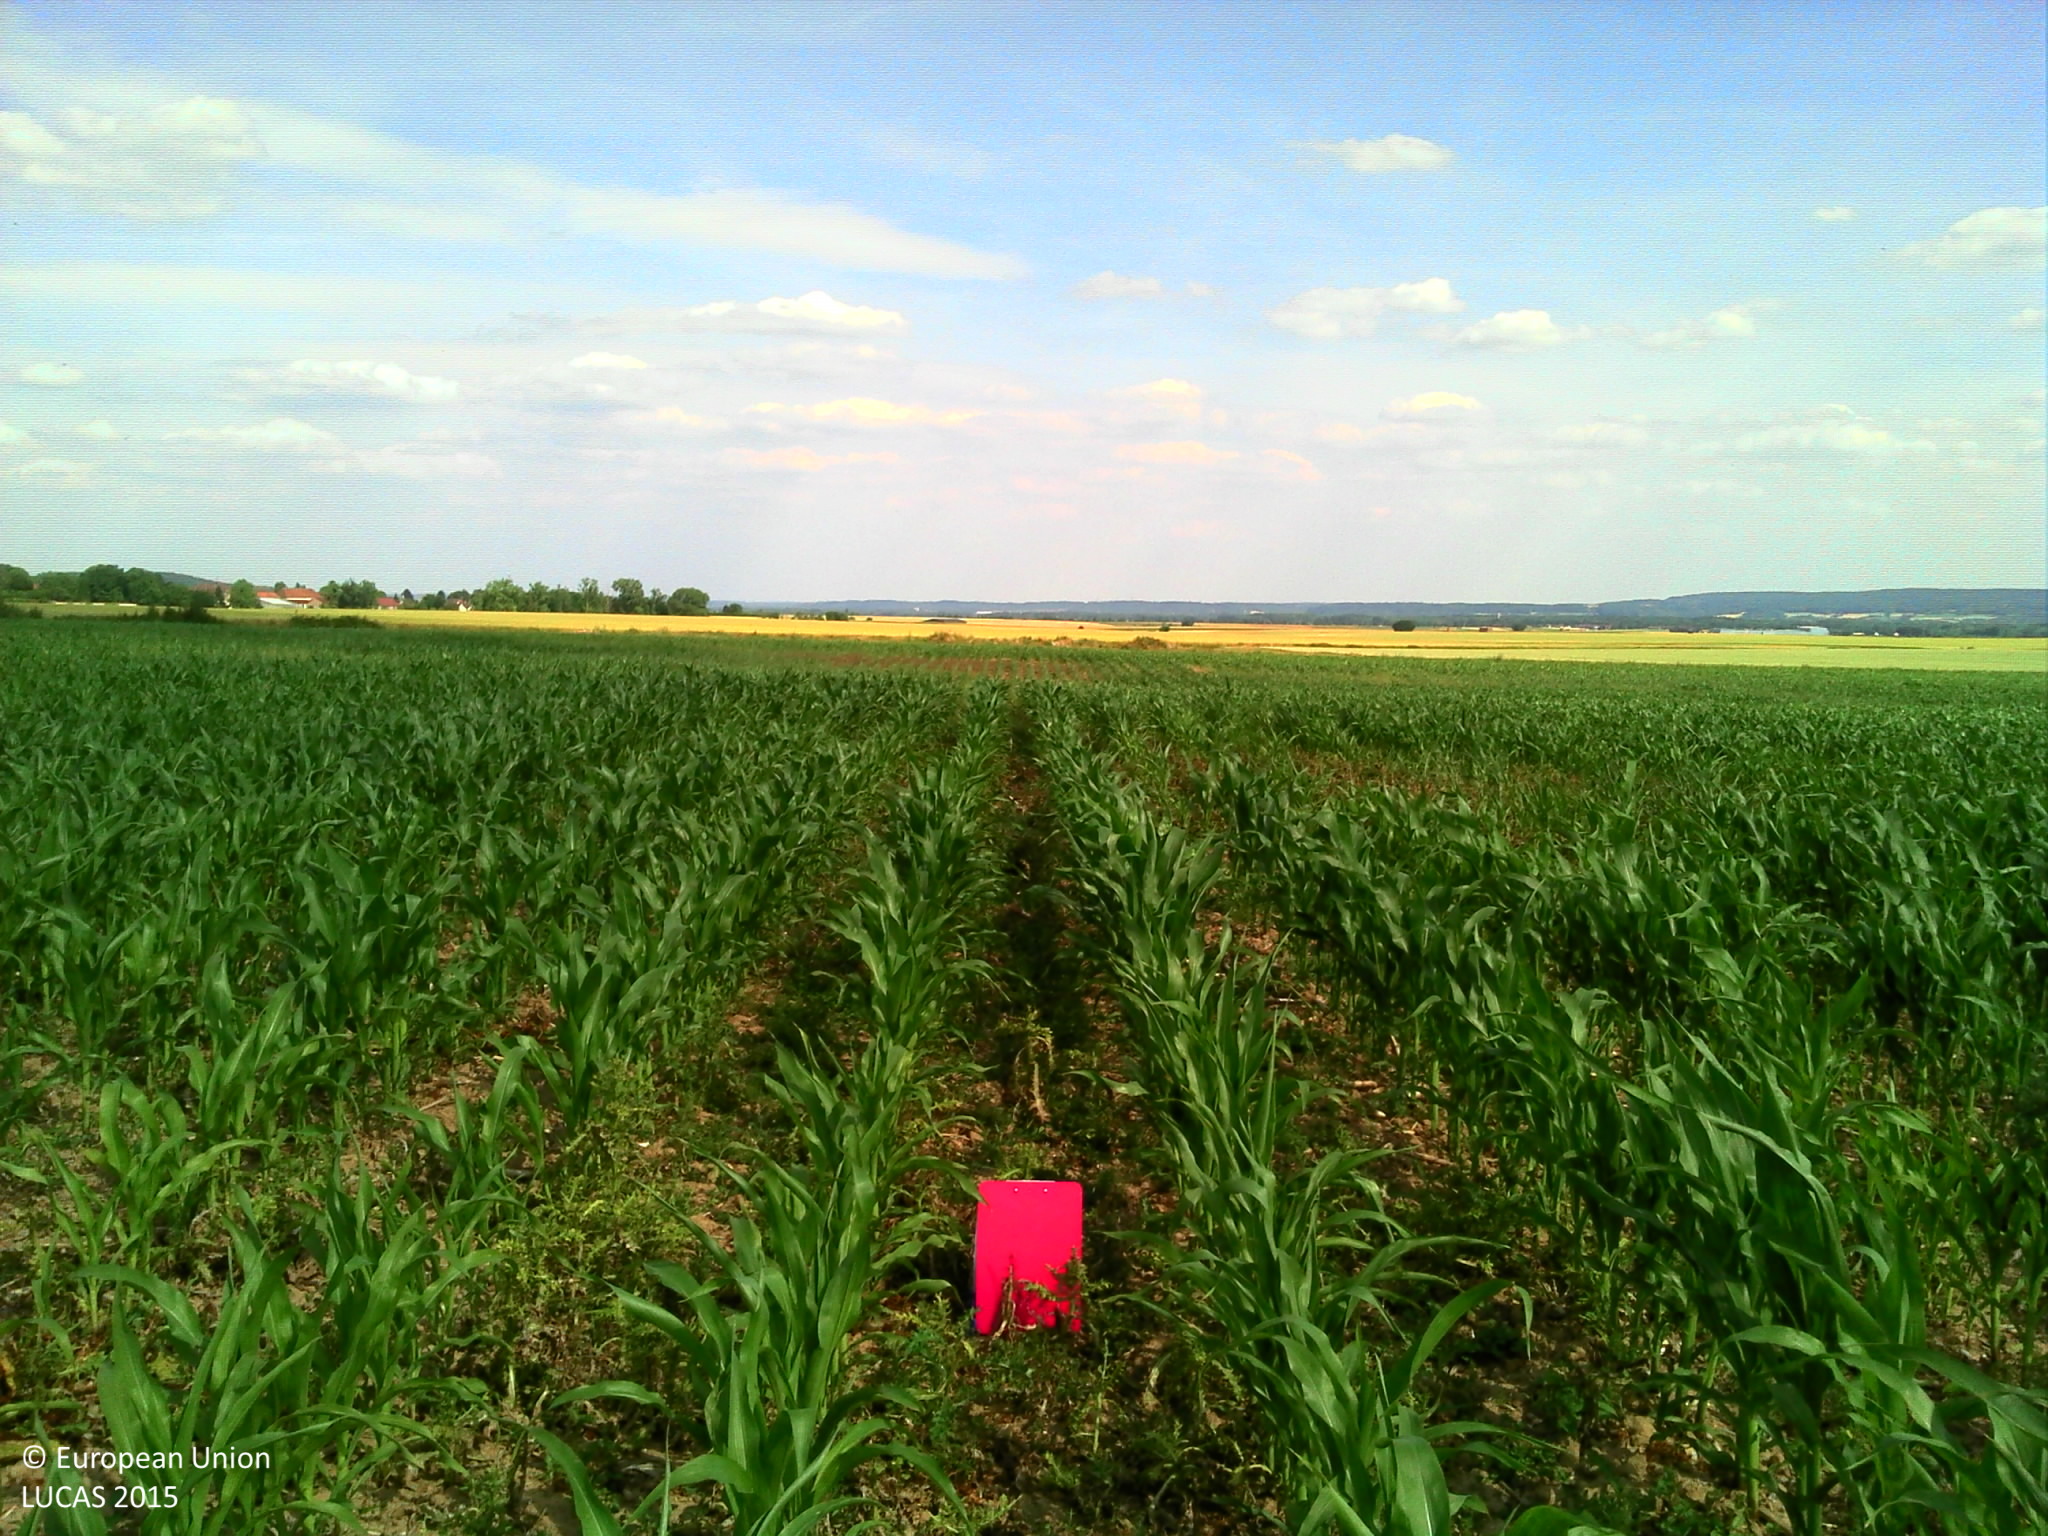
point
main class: Cropland
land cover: Maize
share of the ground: 50 - 75 %
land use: Agriculture (excluding fallow land and kitchen gardens)
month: June
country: FR
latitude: 49.3814
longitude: 2.5639
